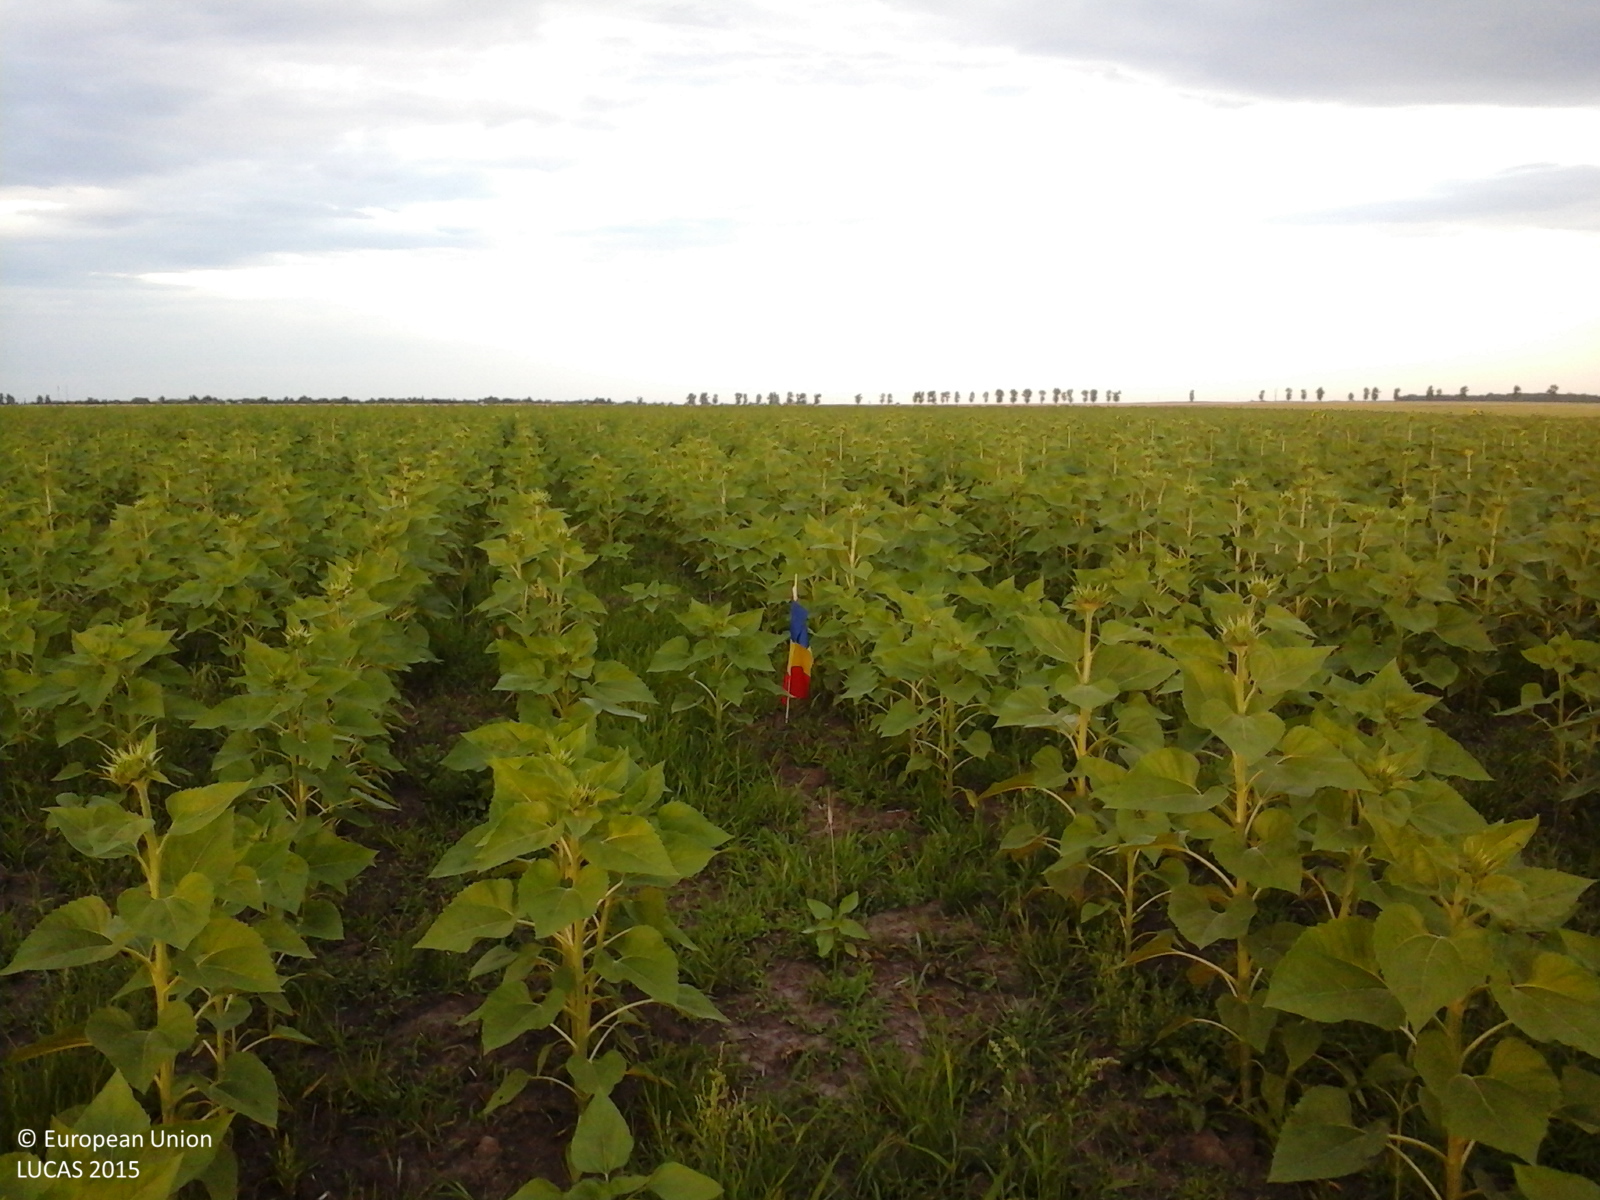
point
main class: Cropland
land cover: Sunflower
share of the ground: 50 - 75 %
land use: Agriculture (excluding fallow land and kitchen gardens)
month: July
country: RO
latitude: 44.3317
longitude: 24.8880
